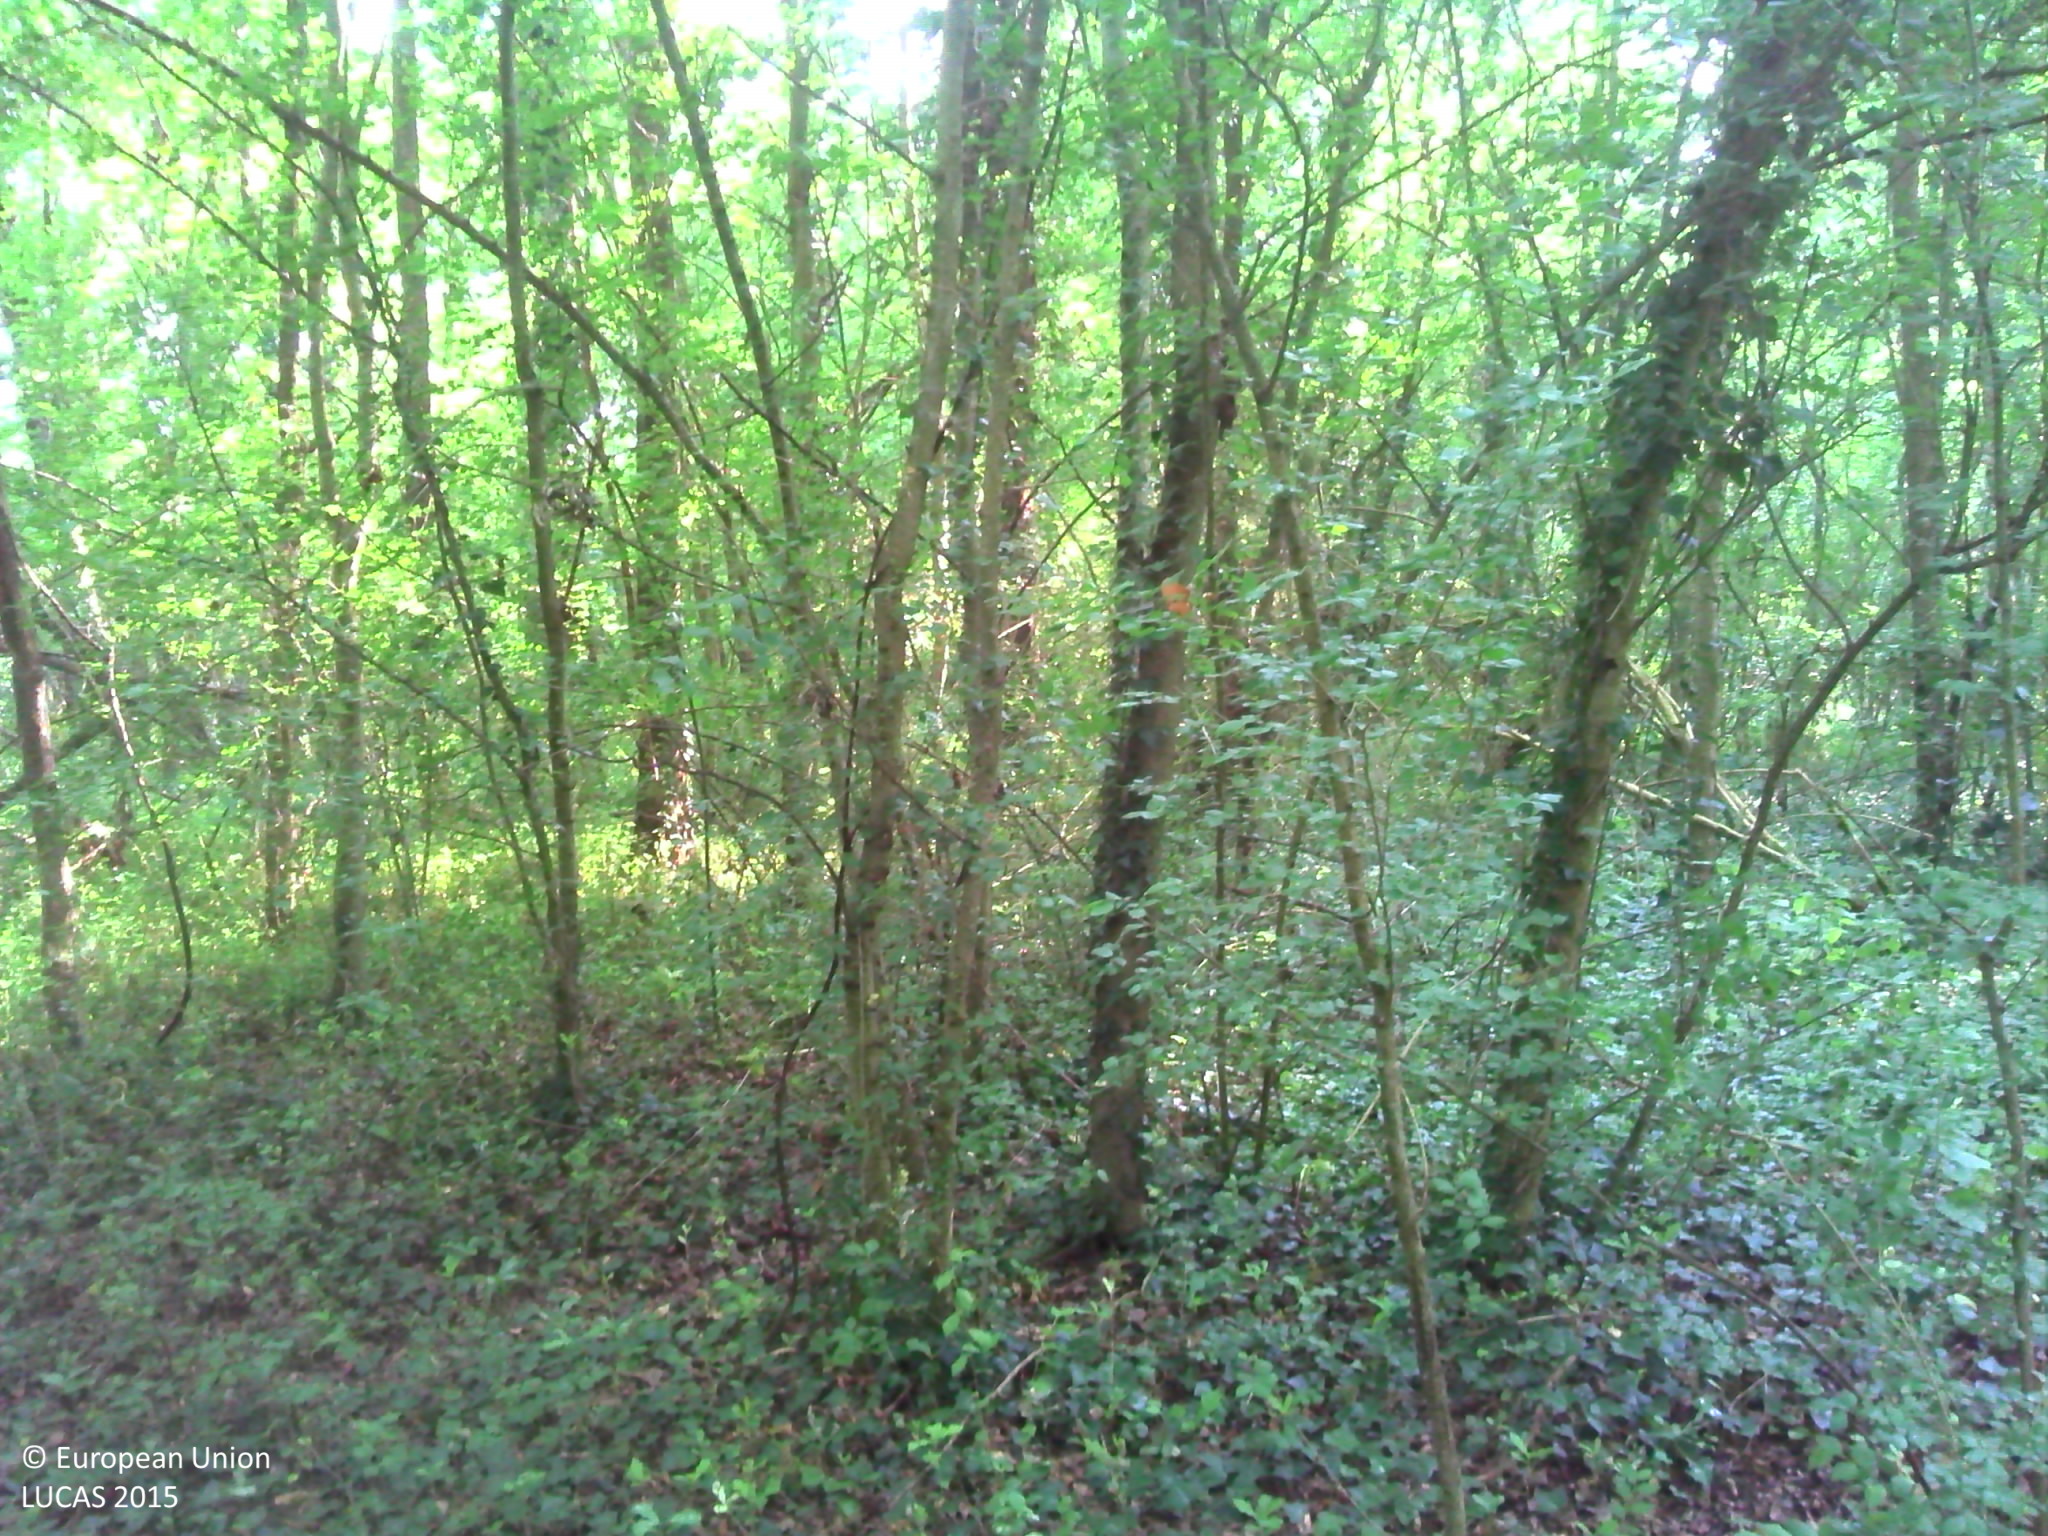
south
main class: Woodland
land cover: Broadleaved woodland
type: mesophytic deciduous forest
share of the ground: > 75 %
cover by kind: broadleaved forest trees 80 %, herbaceous plants 10 %, shrubs 5 %, lichens and mosses 5 %
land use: Forestry
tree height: > 5 m
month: July
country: FR
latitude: 47.2136
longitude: 0.0864
